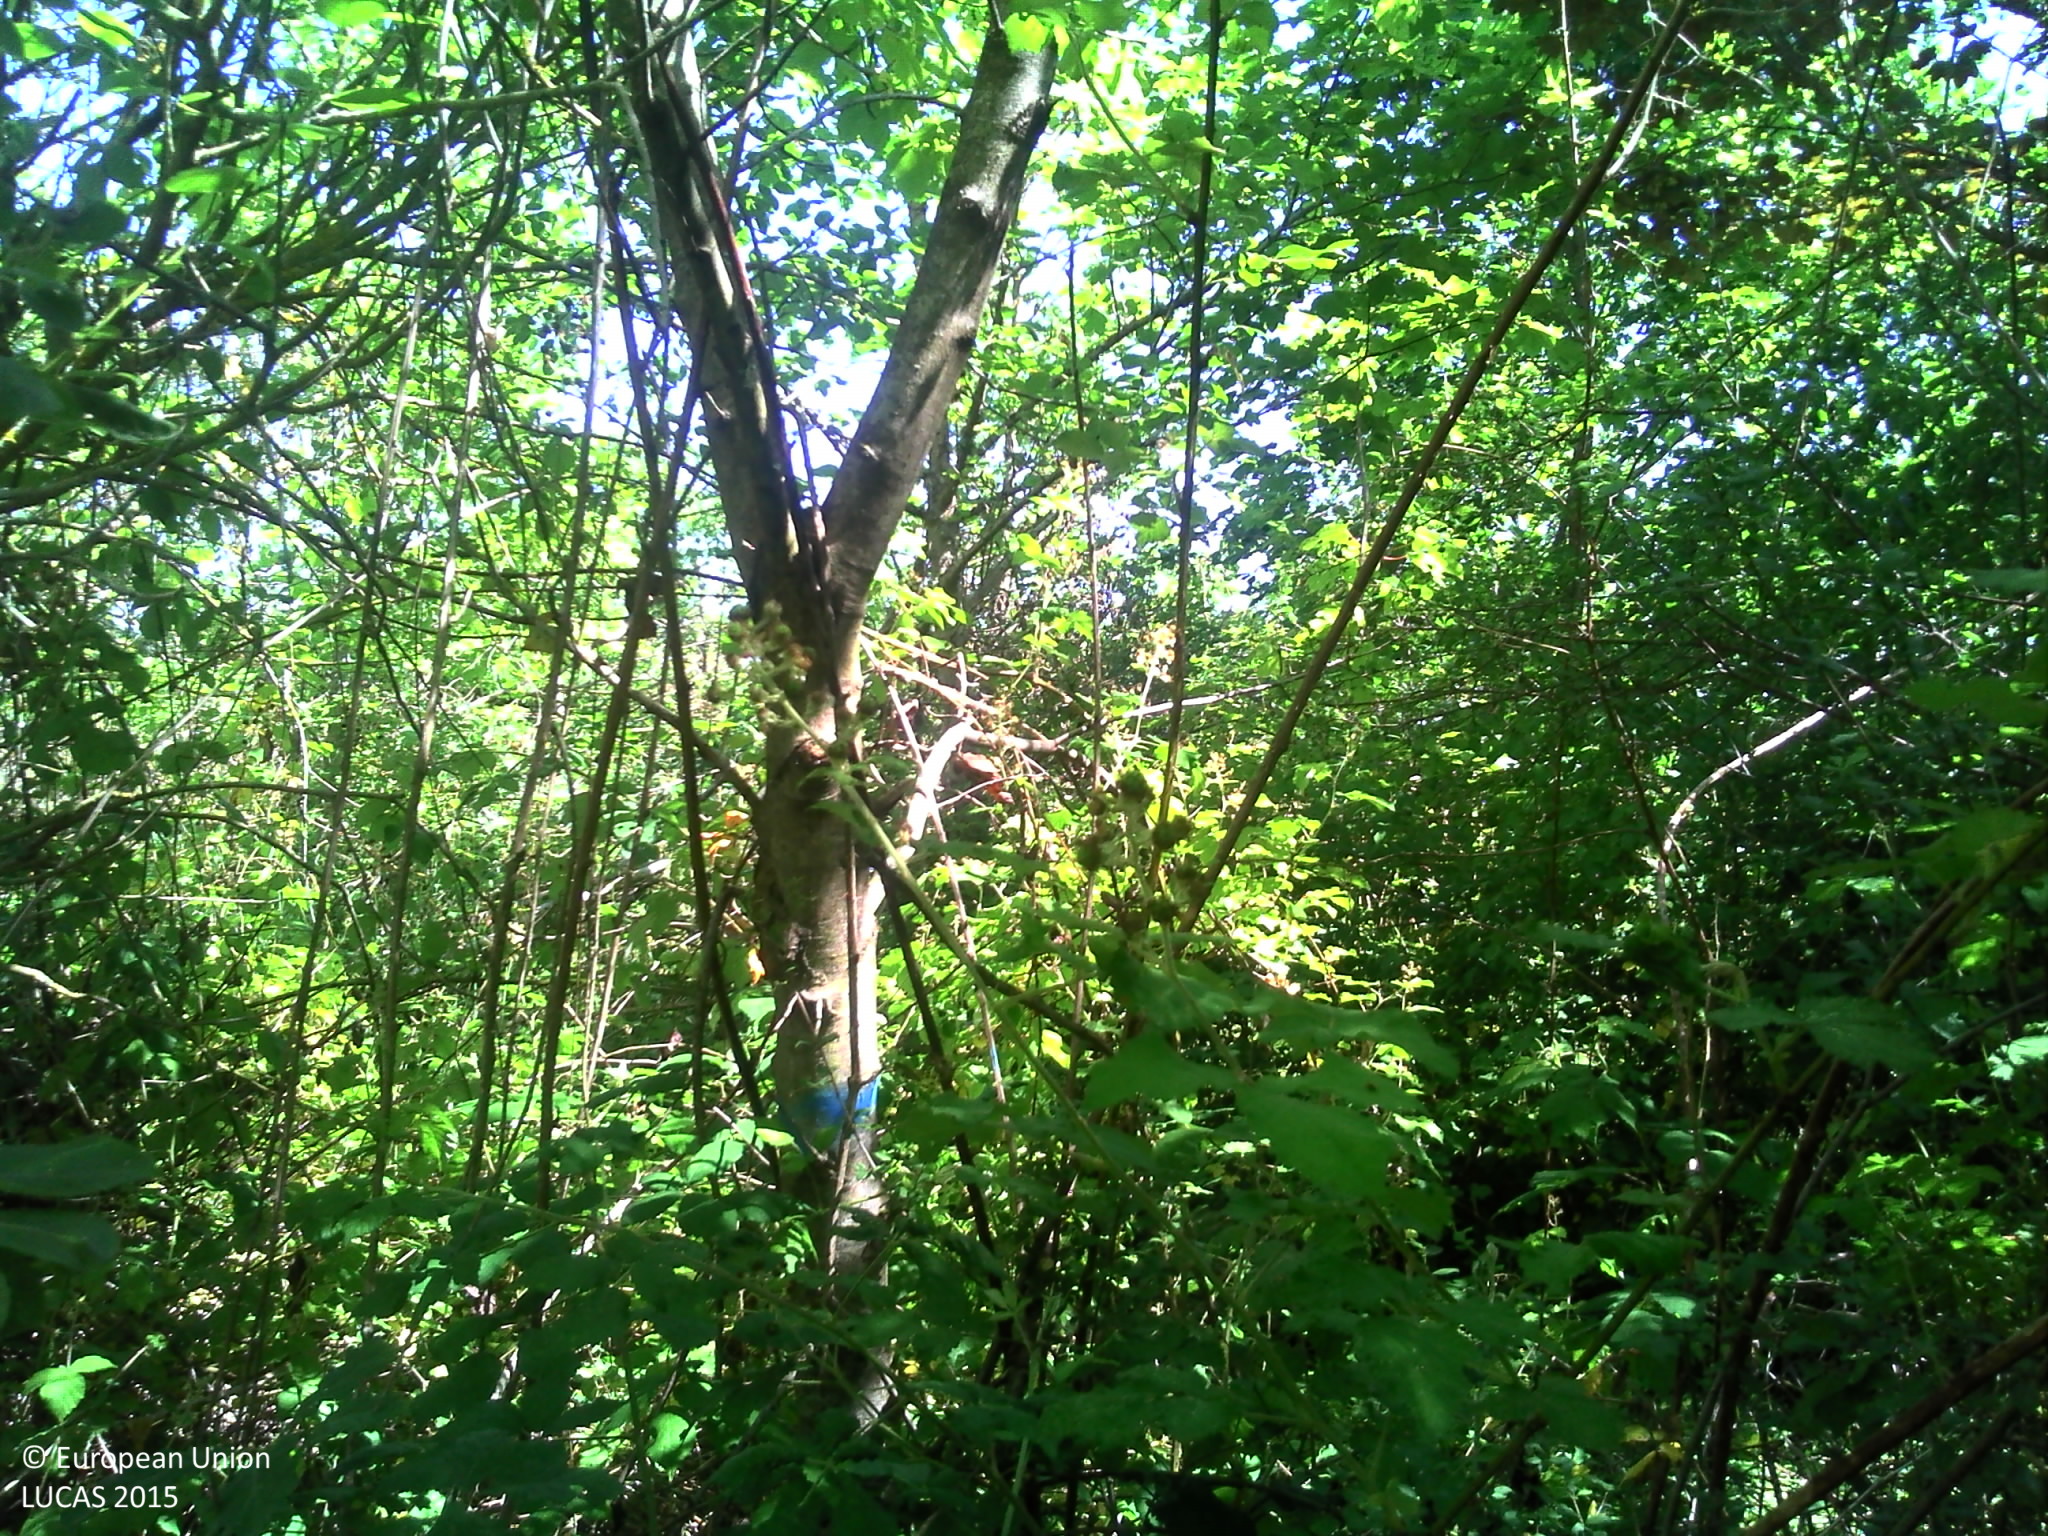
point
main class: Woodland
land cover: Broadleaved woodland
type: mesophytic deciduous forest
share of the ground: > 75 %
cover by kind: broadleaved forest trees 100 %
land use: Forestry
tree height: > 5 m
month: June
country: FR
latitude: 47.6101
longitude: 2.8229
